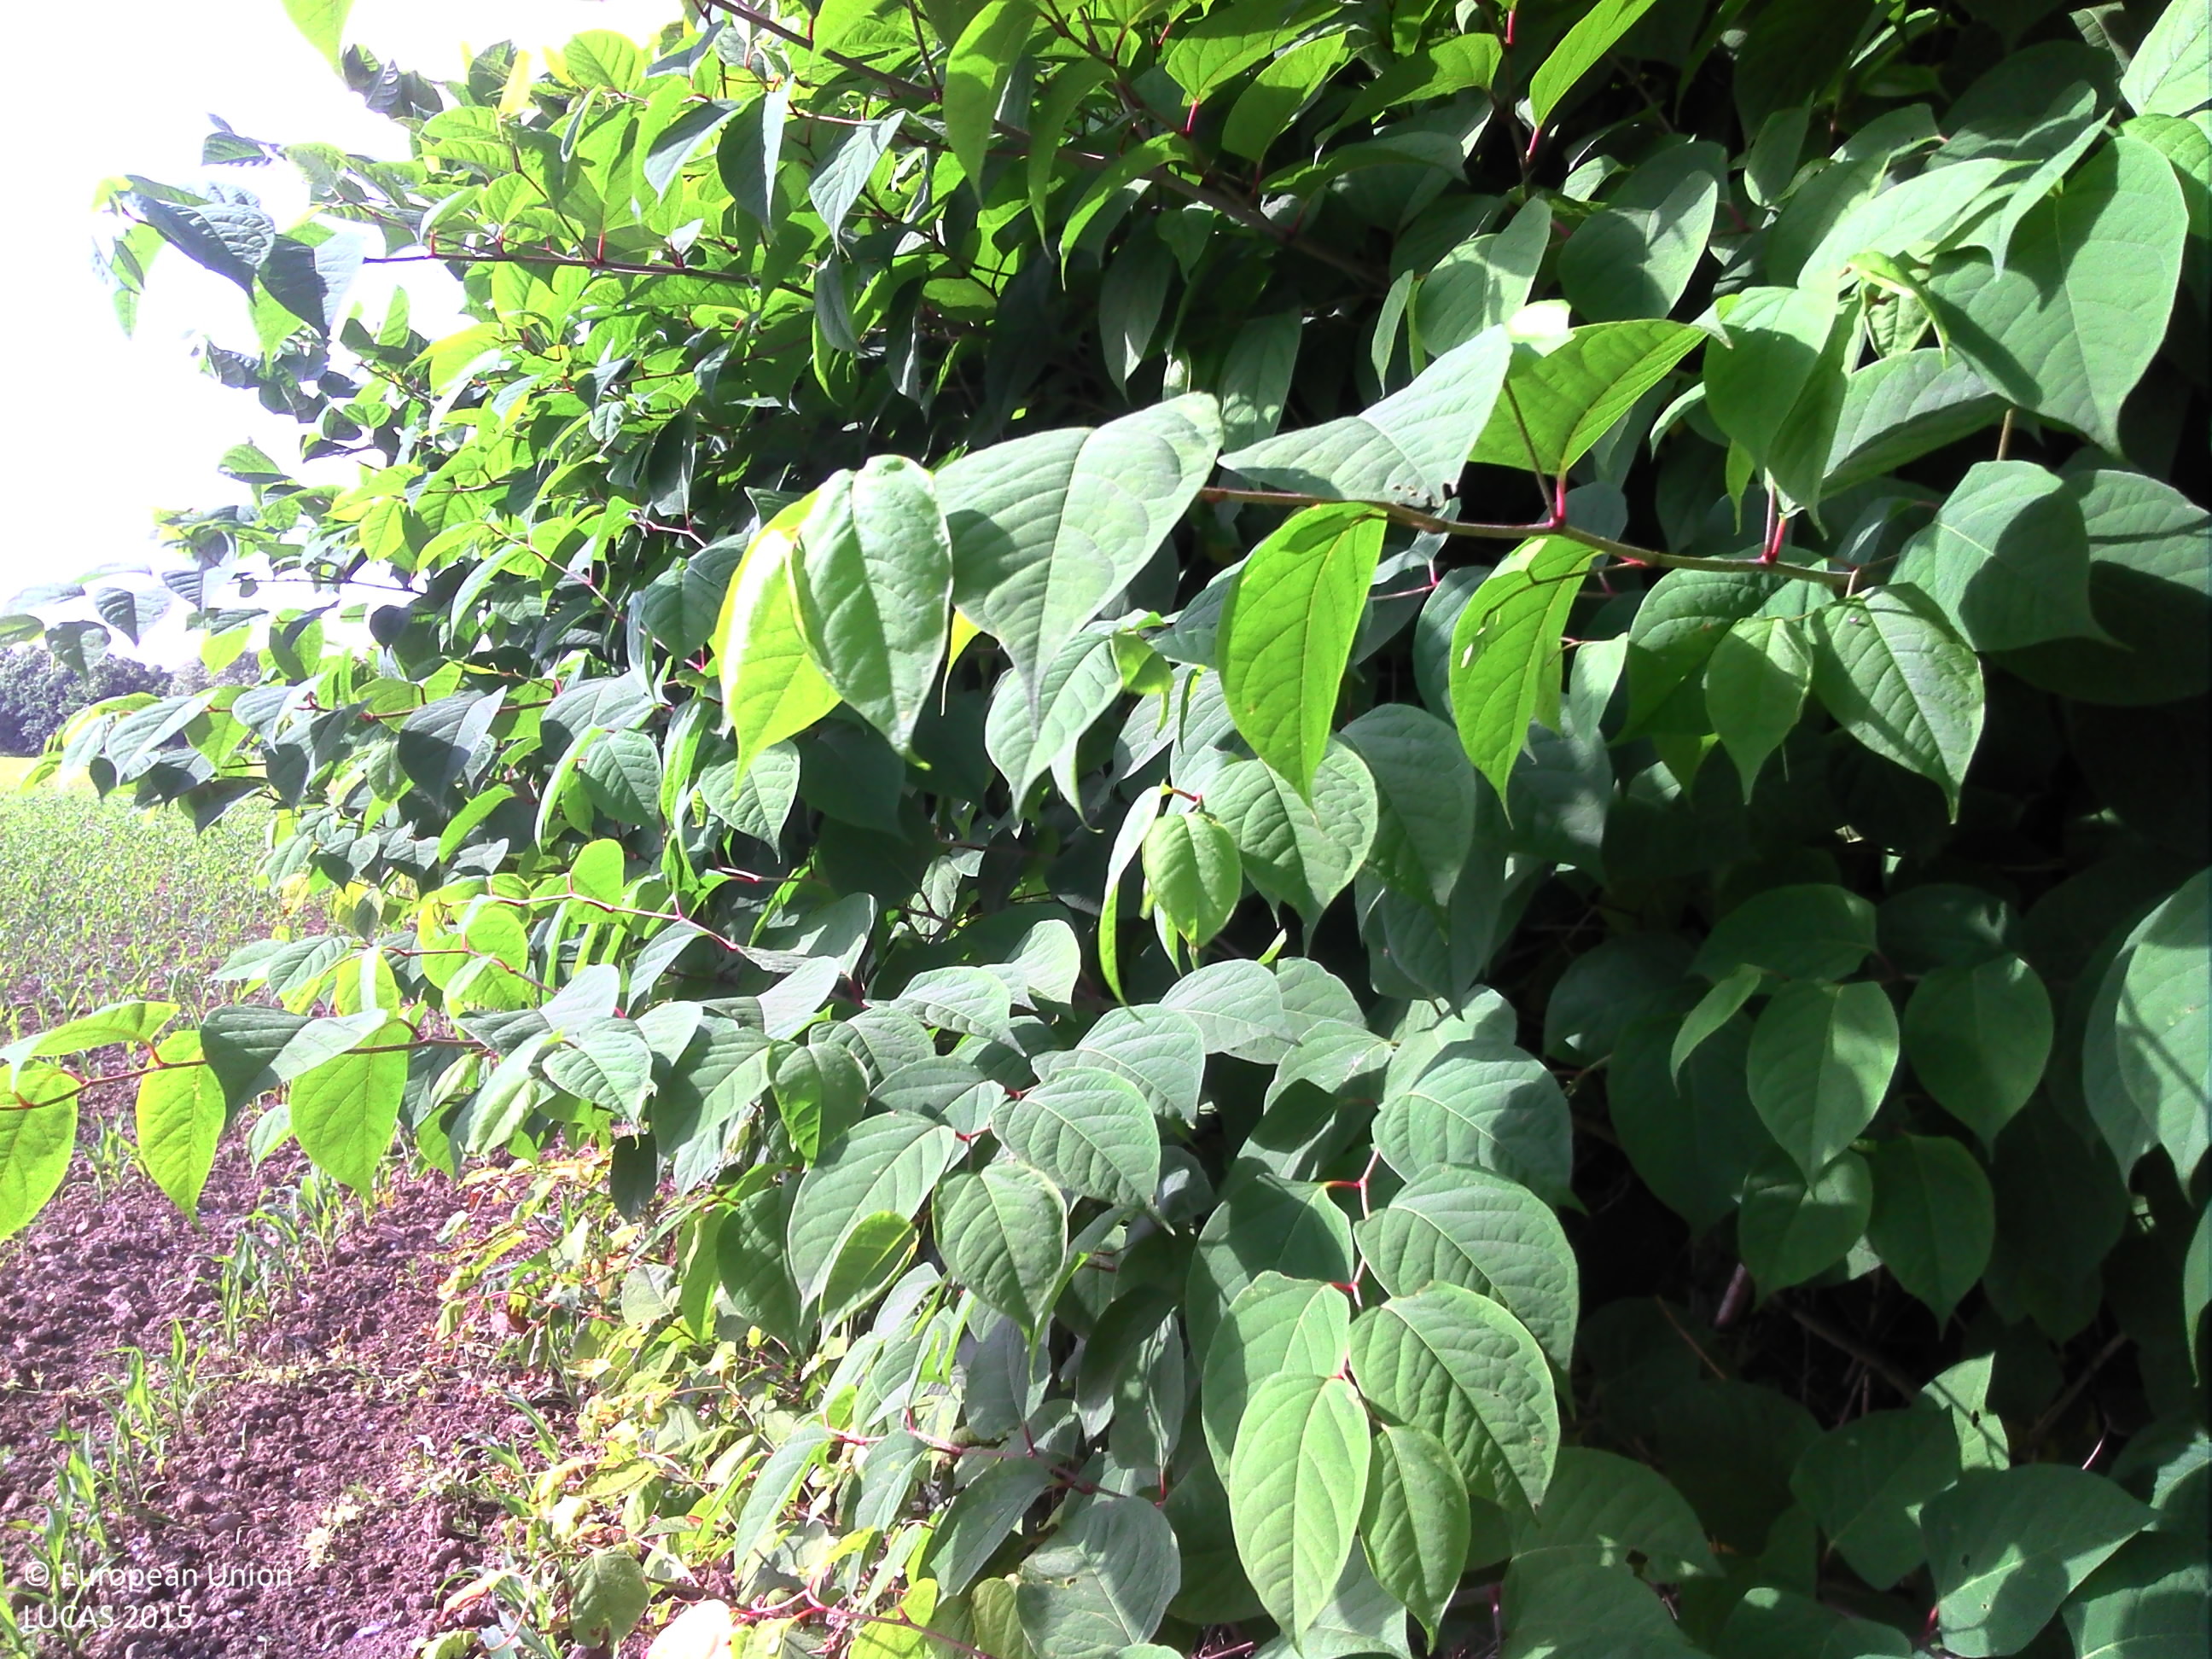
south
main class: Grassland
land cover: Spontaneously vegetated surfaces
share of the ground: > 75 %
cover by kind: herbaceous plants 100 %
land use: Semi-natural and natural areas not in use
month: June
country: BE
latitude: 51.0777
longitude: 5.7593
